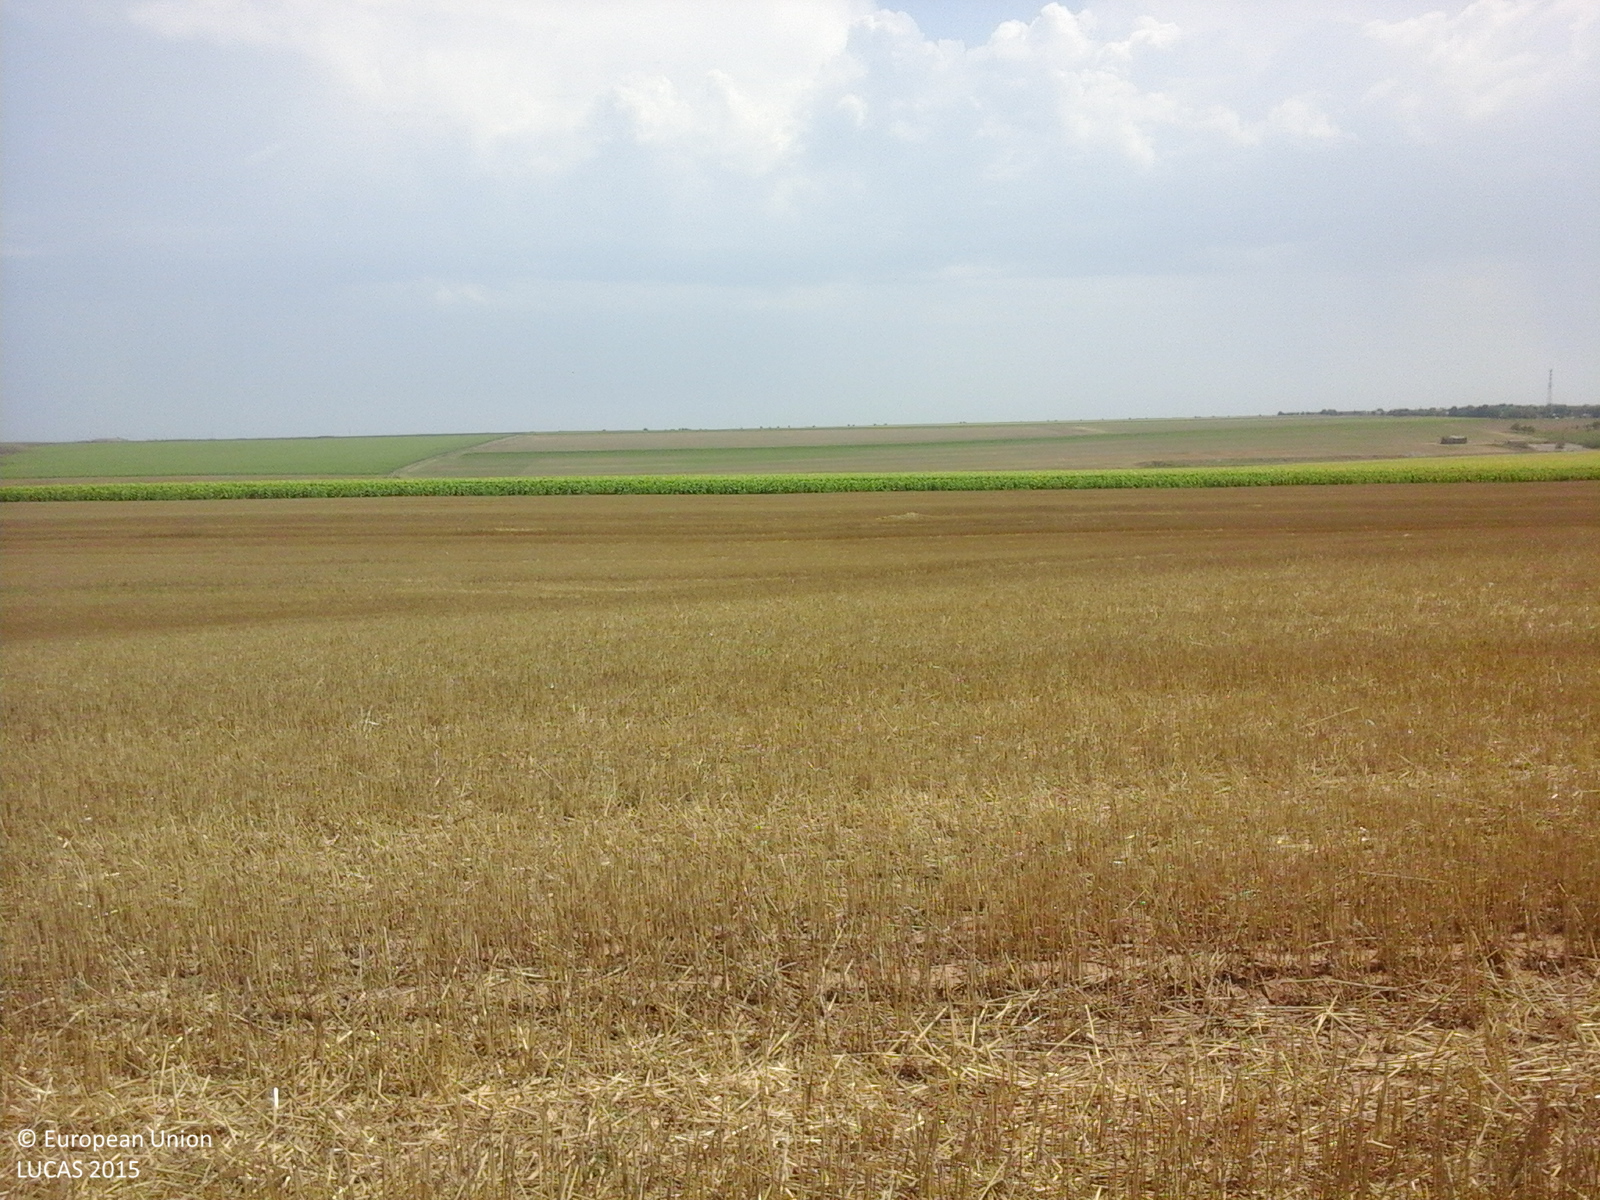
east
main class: Cropland
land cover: Common wheat
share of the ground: > 75 %
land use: Agriculture (excluding fallow land and kitchen gardens)
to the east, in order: Common wheat; Sunflower
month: August
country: RO
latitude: 44.0797
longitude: 28.4616
